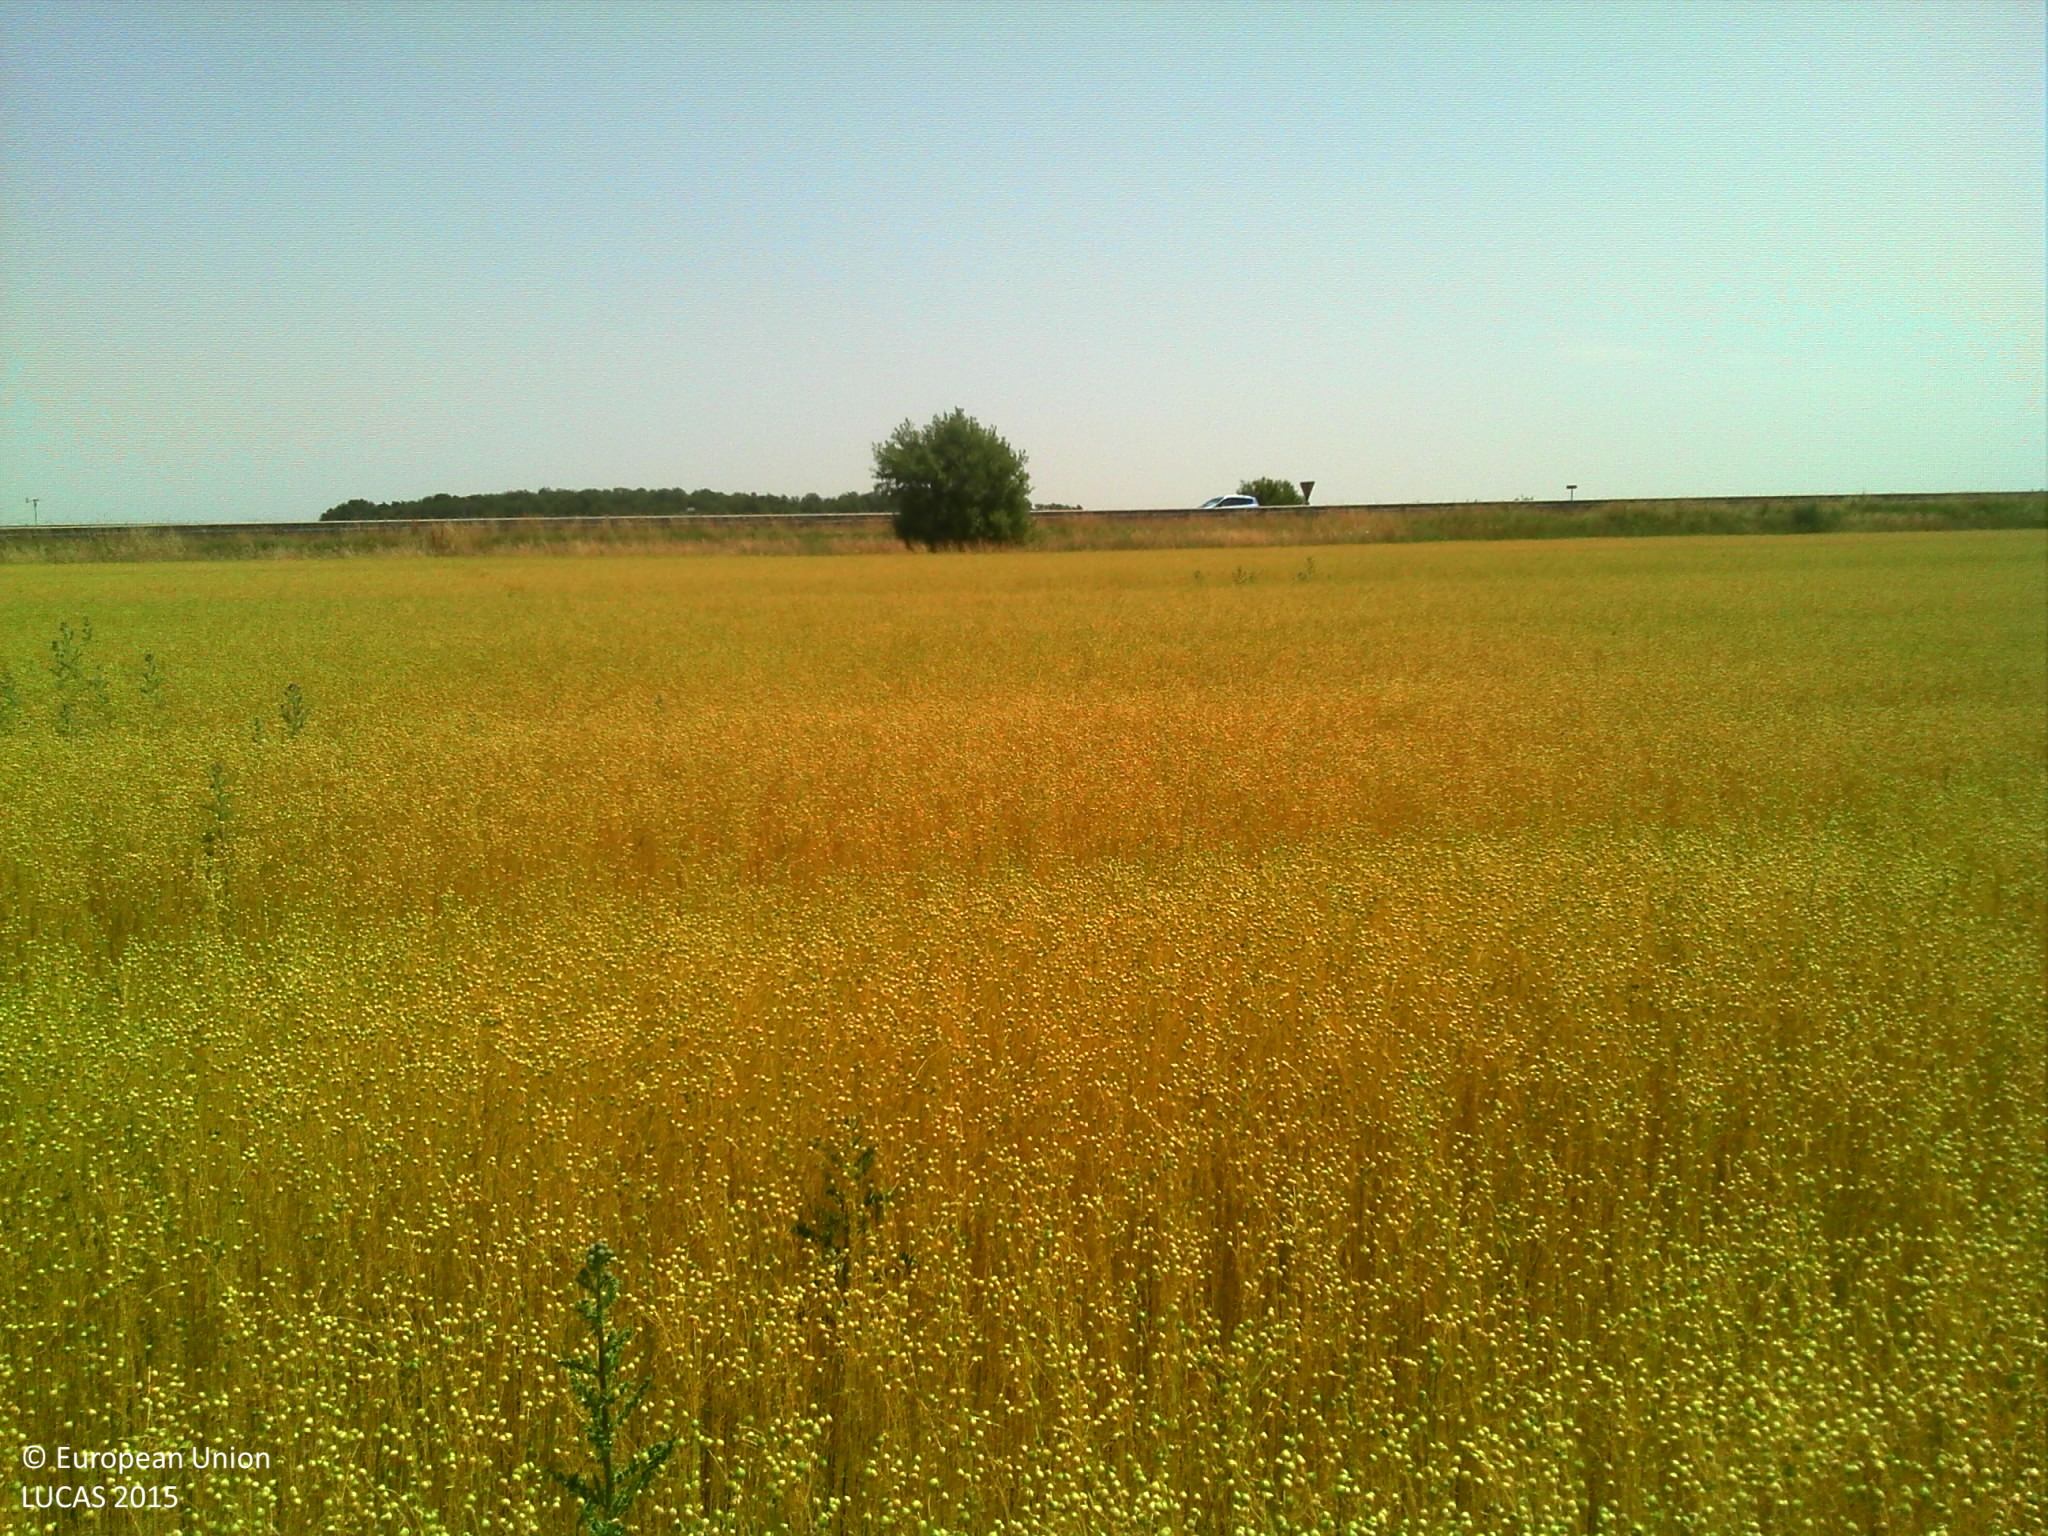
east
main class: Cropland
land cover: Other fibre and oleaginous crops
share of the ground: > 75 %
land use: Agriculture (excluding fallow land and kitchen gardens)
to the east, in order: Other fibre and oleaginous crops; Grassland without tree/shrub cover; Paved roads, cycling and walking lanes; Grassland without tree/shrub cover; Tracks; Common wheat
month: July
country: FR
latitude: 48.9568
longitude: 1.1986
